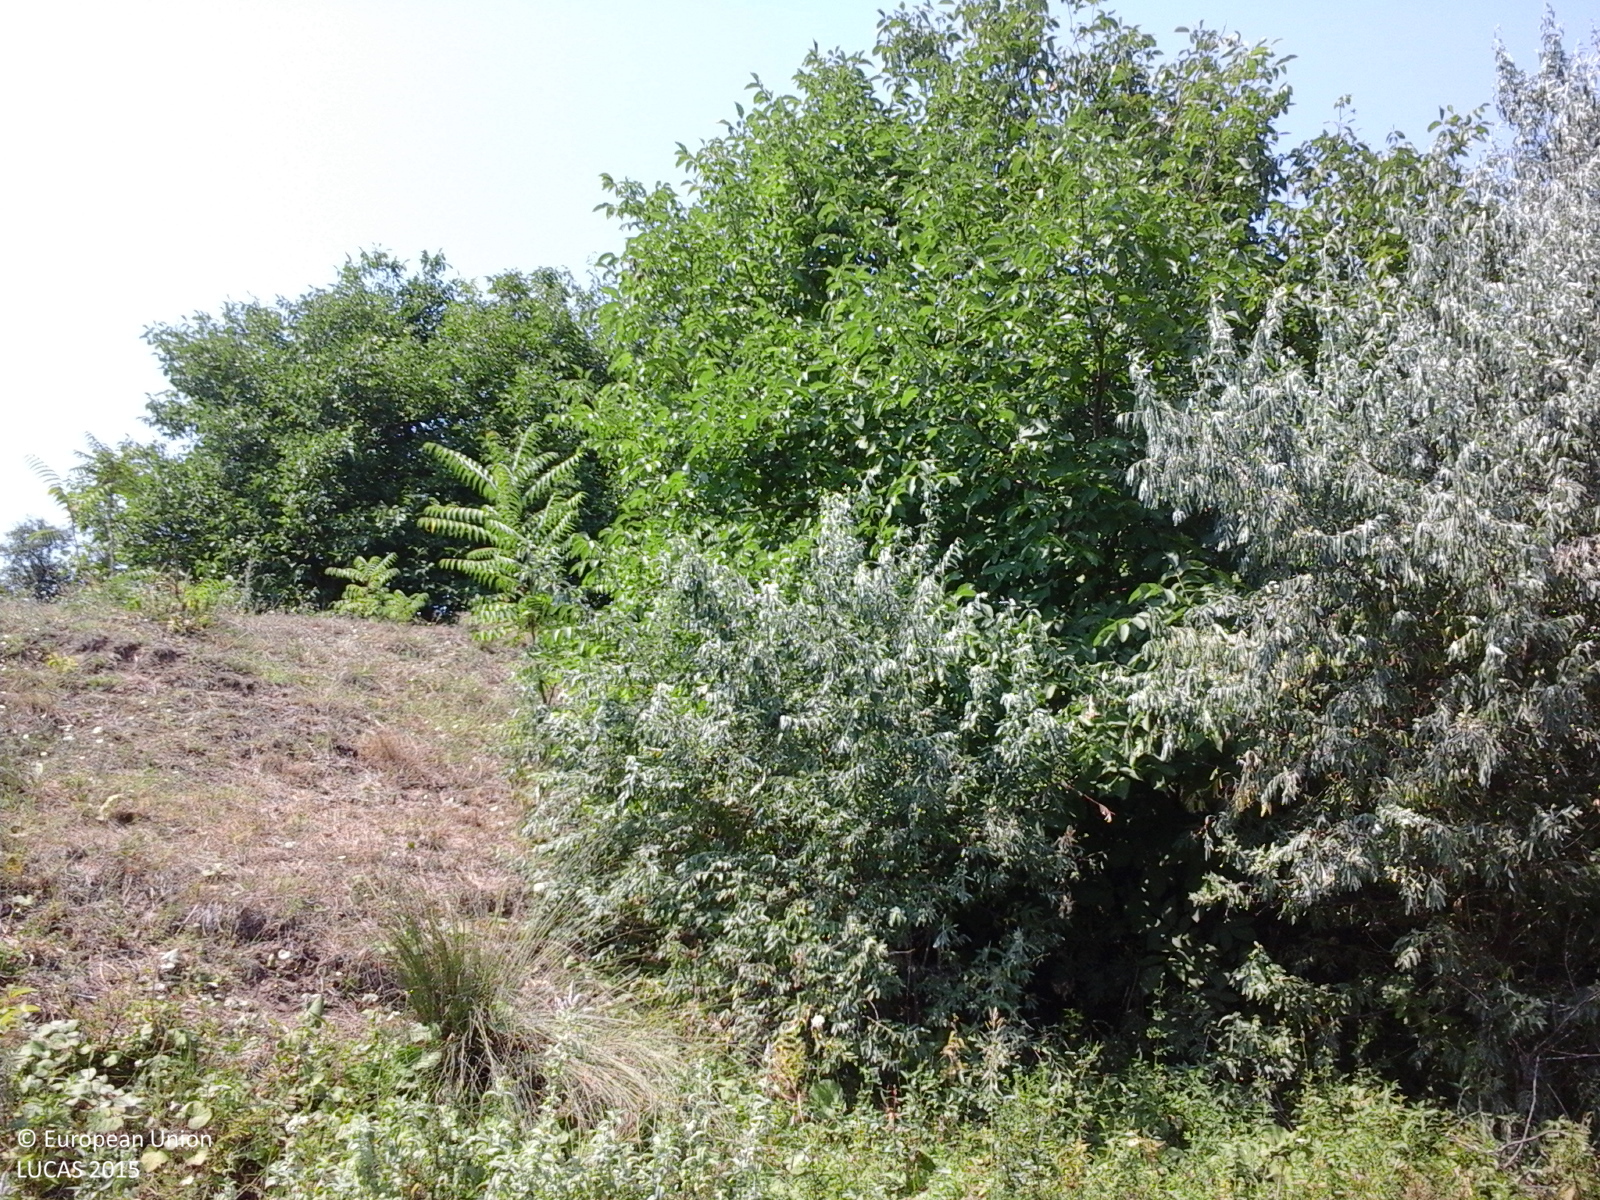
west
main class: Grassland
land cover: Grassland without tree/shrub cover
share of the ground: > 75 %
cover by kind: herbaceous plants 100 %
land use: Agriculture (excluding fallow land and kitchen gardens)
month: July
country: RO
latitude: 45.8350
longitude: 27.9234
